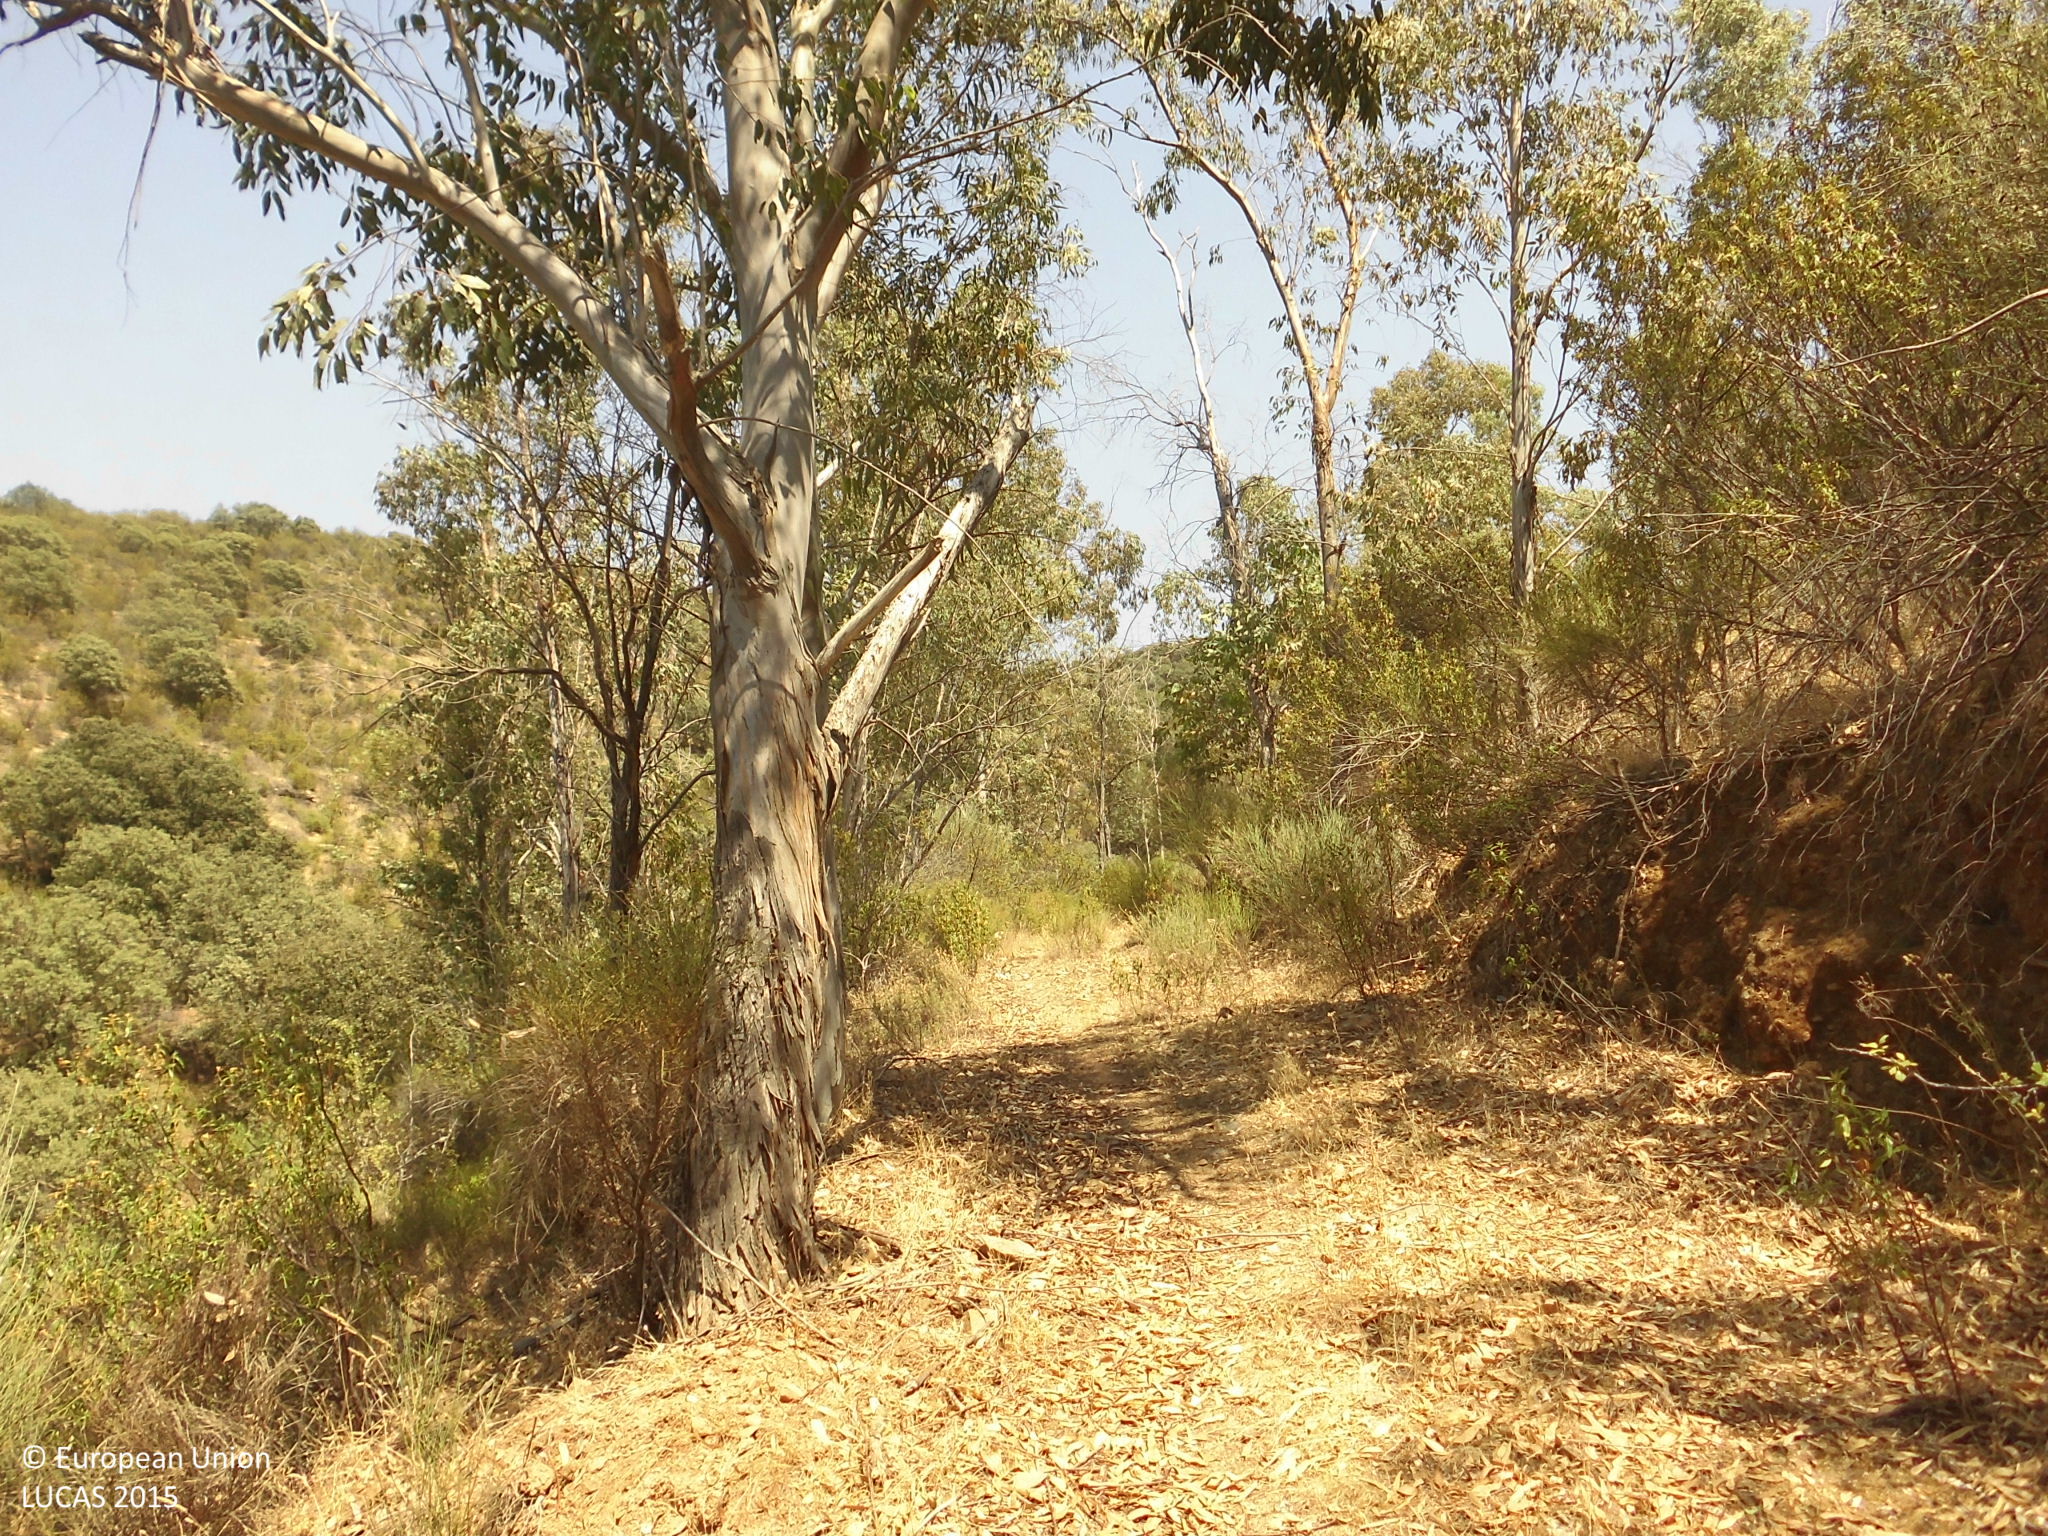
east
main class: Woodland
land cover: Broadleaved woodland
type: exotic forest
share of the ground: 50 - 75 %
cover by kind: broadleaved forest trees 75 %, shrubs 20 %, herbaceous plants 5 %
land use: Forestry
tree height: > 5 m
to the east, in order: Broadleaved woodland; Shrubland without tree cover; Broadleaved woodland; Shrubland with sparse tree cover; Rivers and streams
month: July
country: ES
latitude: 39.7205
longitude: -5.4179
